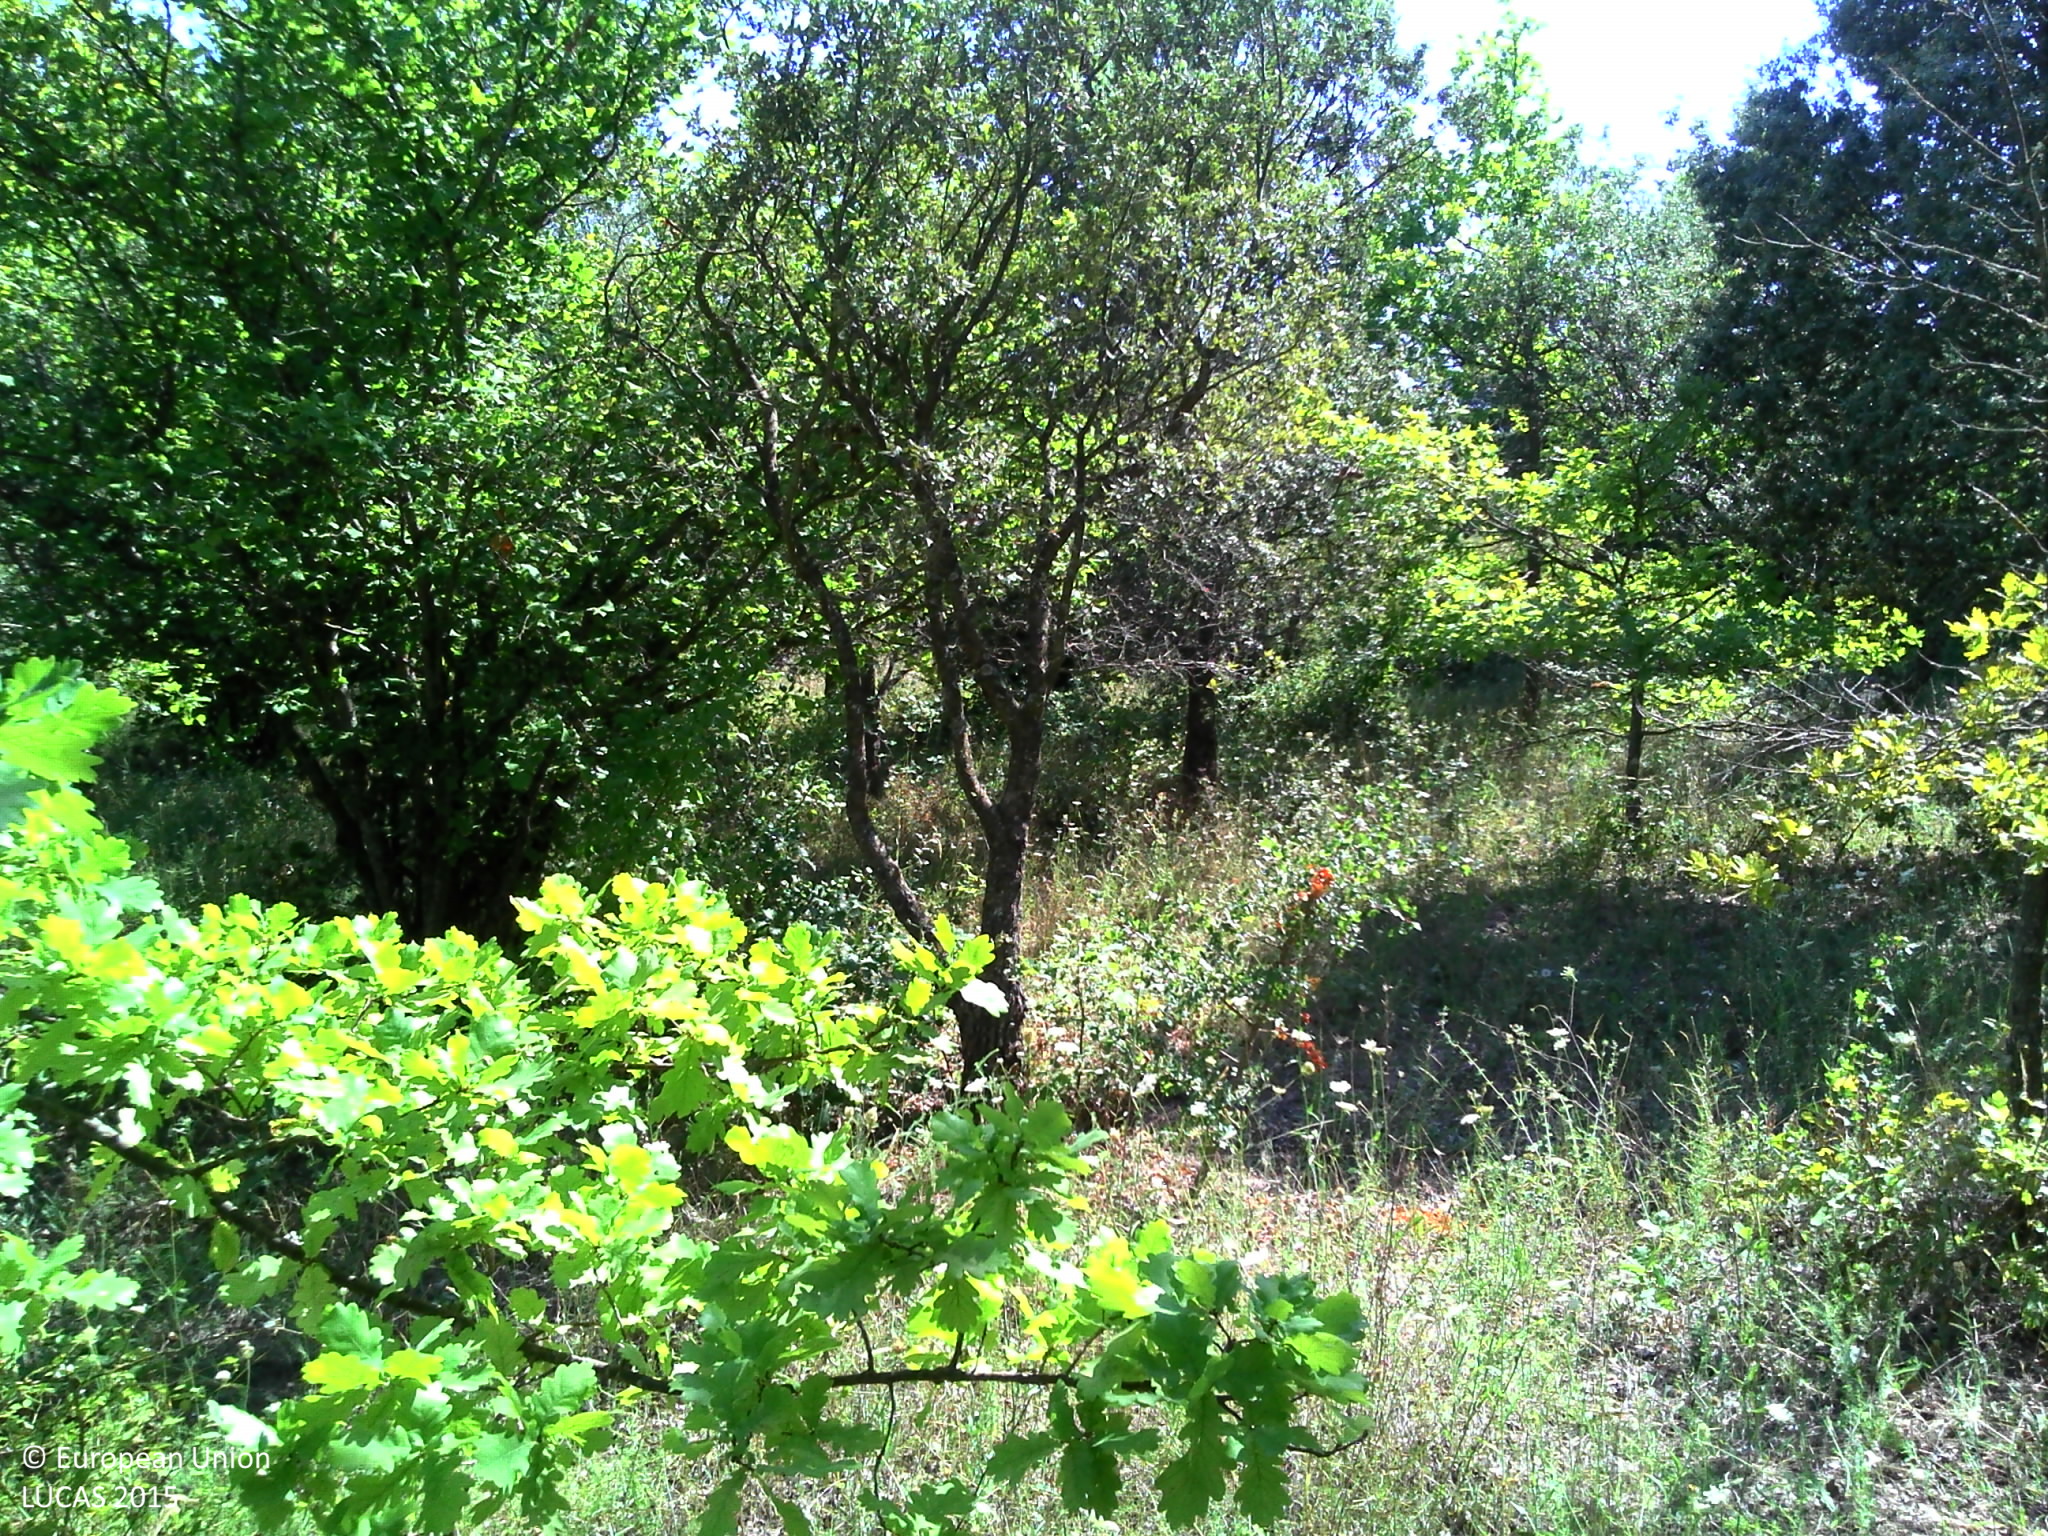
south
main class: Grassland
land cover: Grassland with sparse tree/shrub cover
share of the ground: > 75 %
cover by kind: herbaceous plants 95 %, broadleaved forest trees 5 %
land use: Agriculture (excluding fallow land and kitchen gardens)
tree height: < 5 m
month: August
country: FR
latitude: 43.8115
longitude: 5.3222
